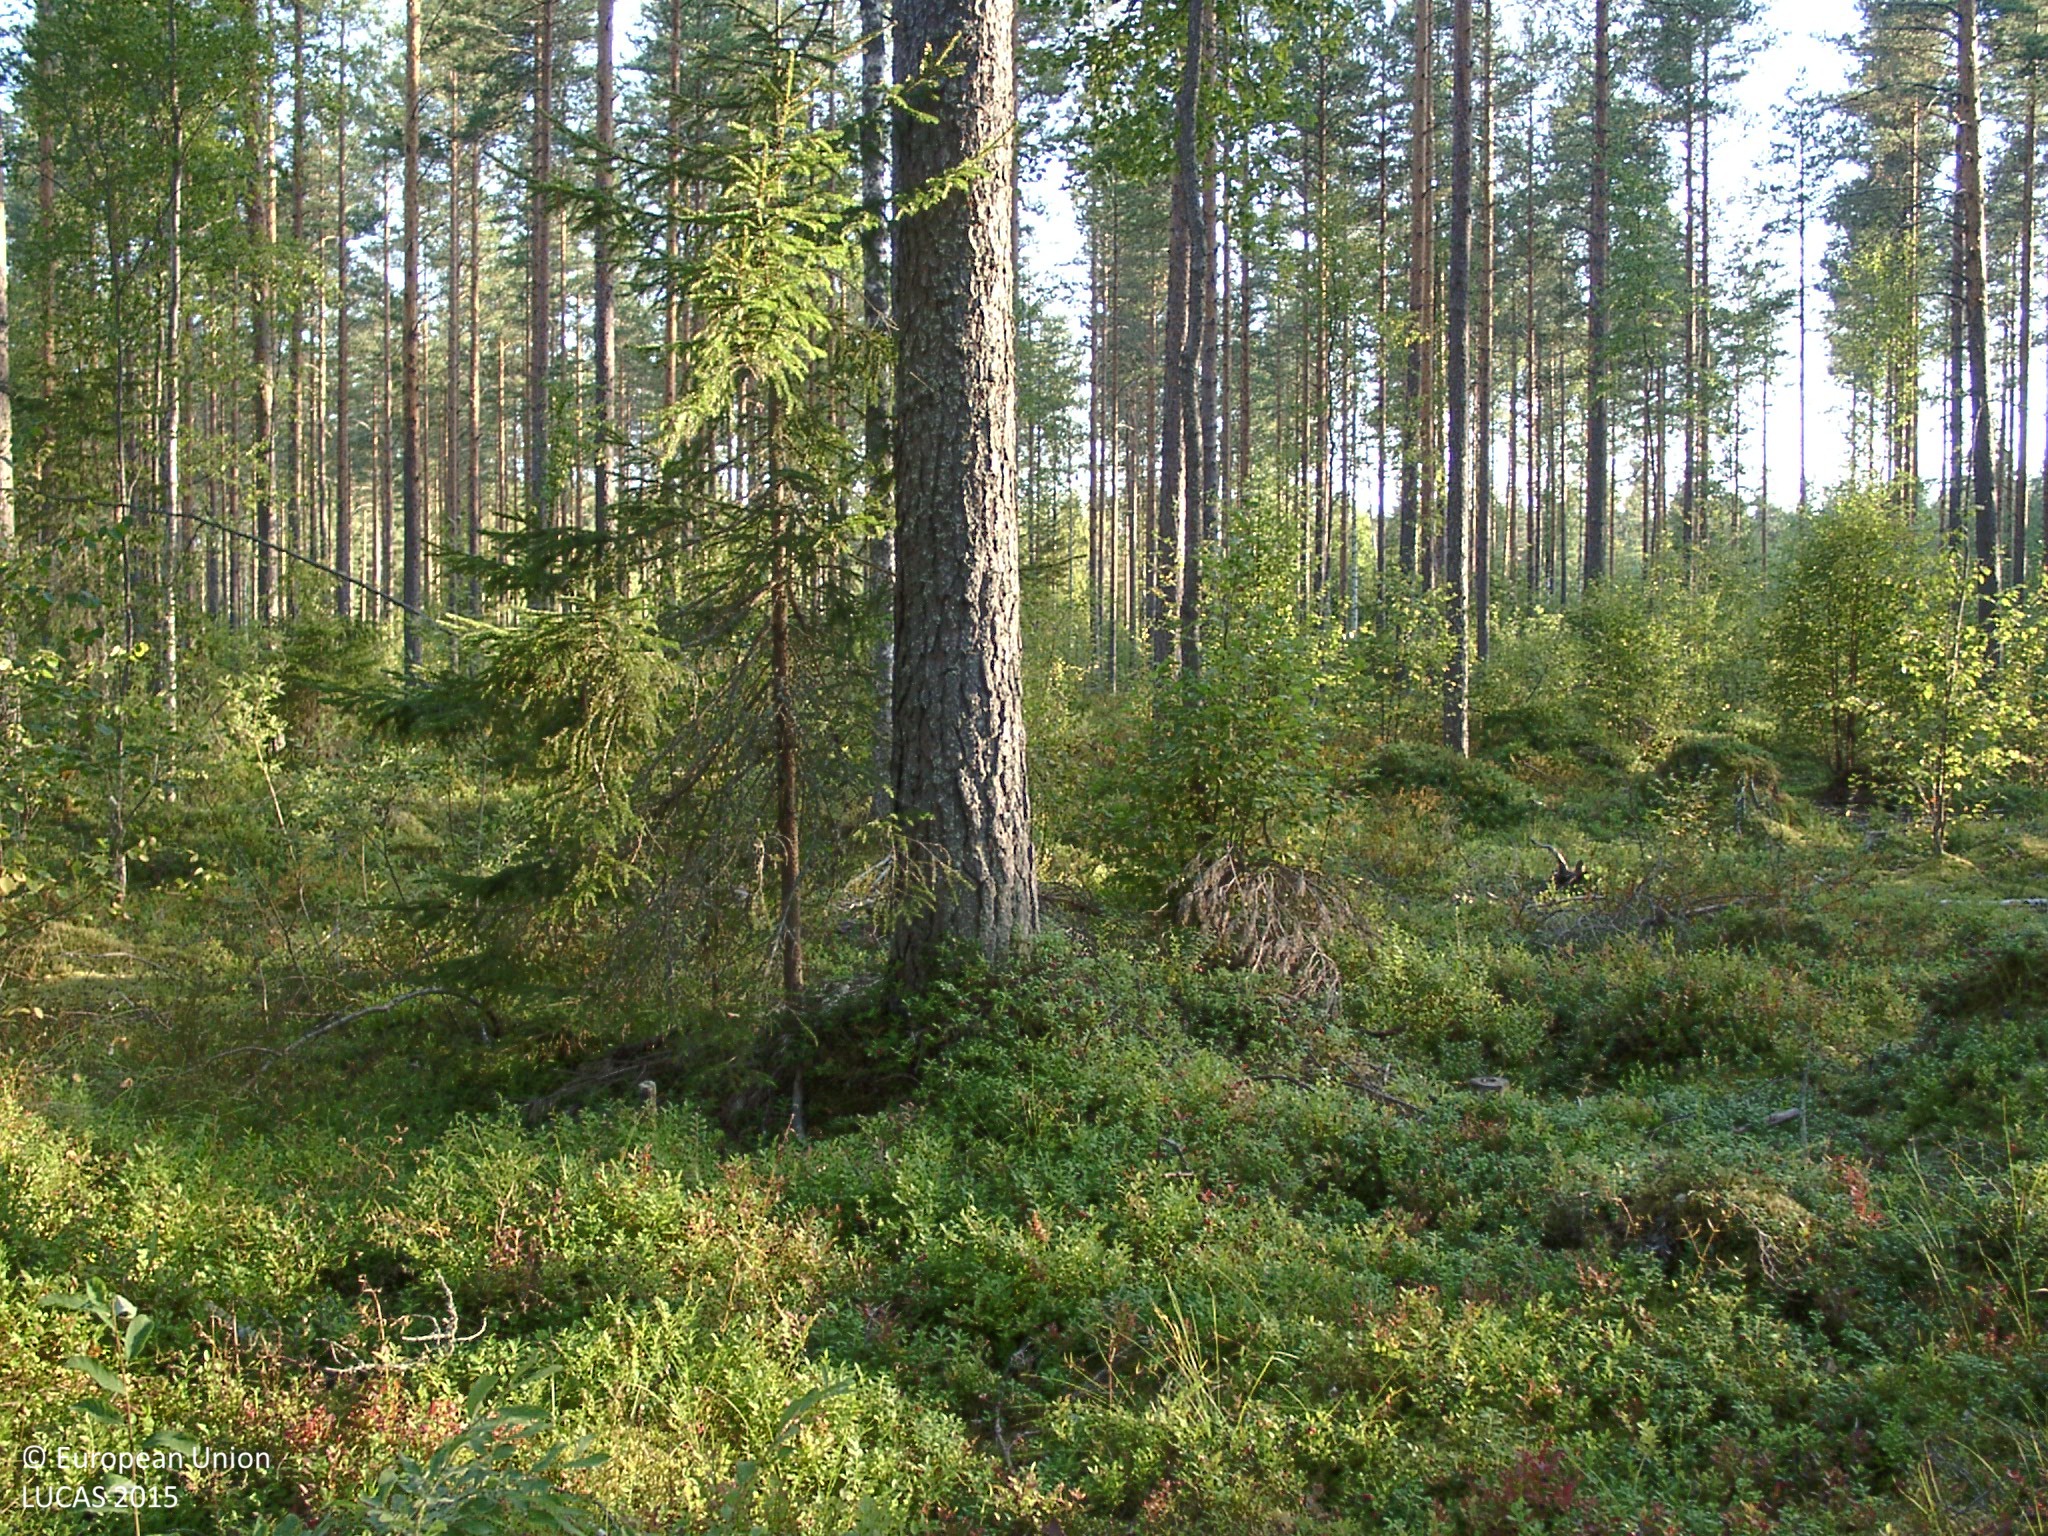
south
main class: Woodland
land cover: Pine dominated coniferous woodland
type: boreal forest
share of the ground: 50 - 75 %
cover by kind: coniferous forest trees 55 %, shrubs 30 %, lichens and mosses 10 %, broadleaved forest trees 5 %
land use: Forestry
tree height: > 5 m
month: August
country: FI
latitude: 61.9361
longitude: 25.1033
